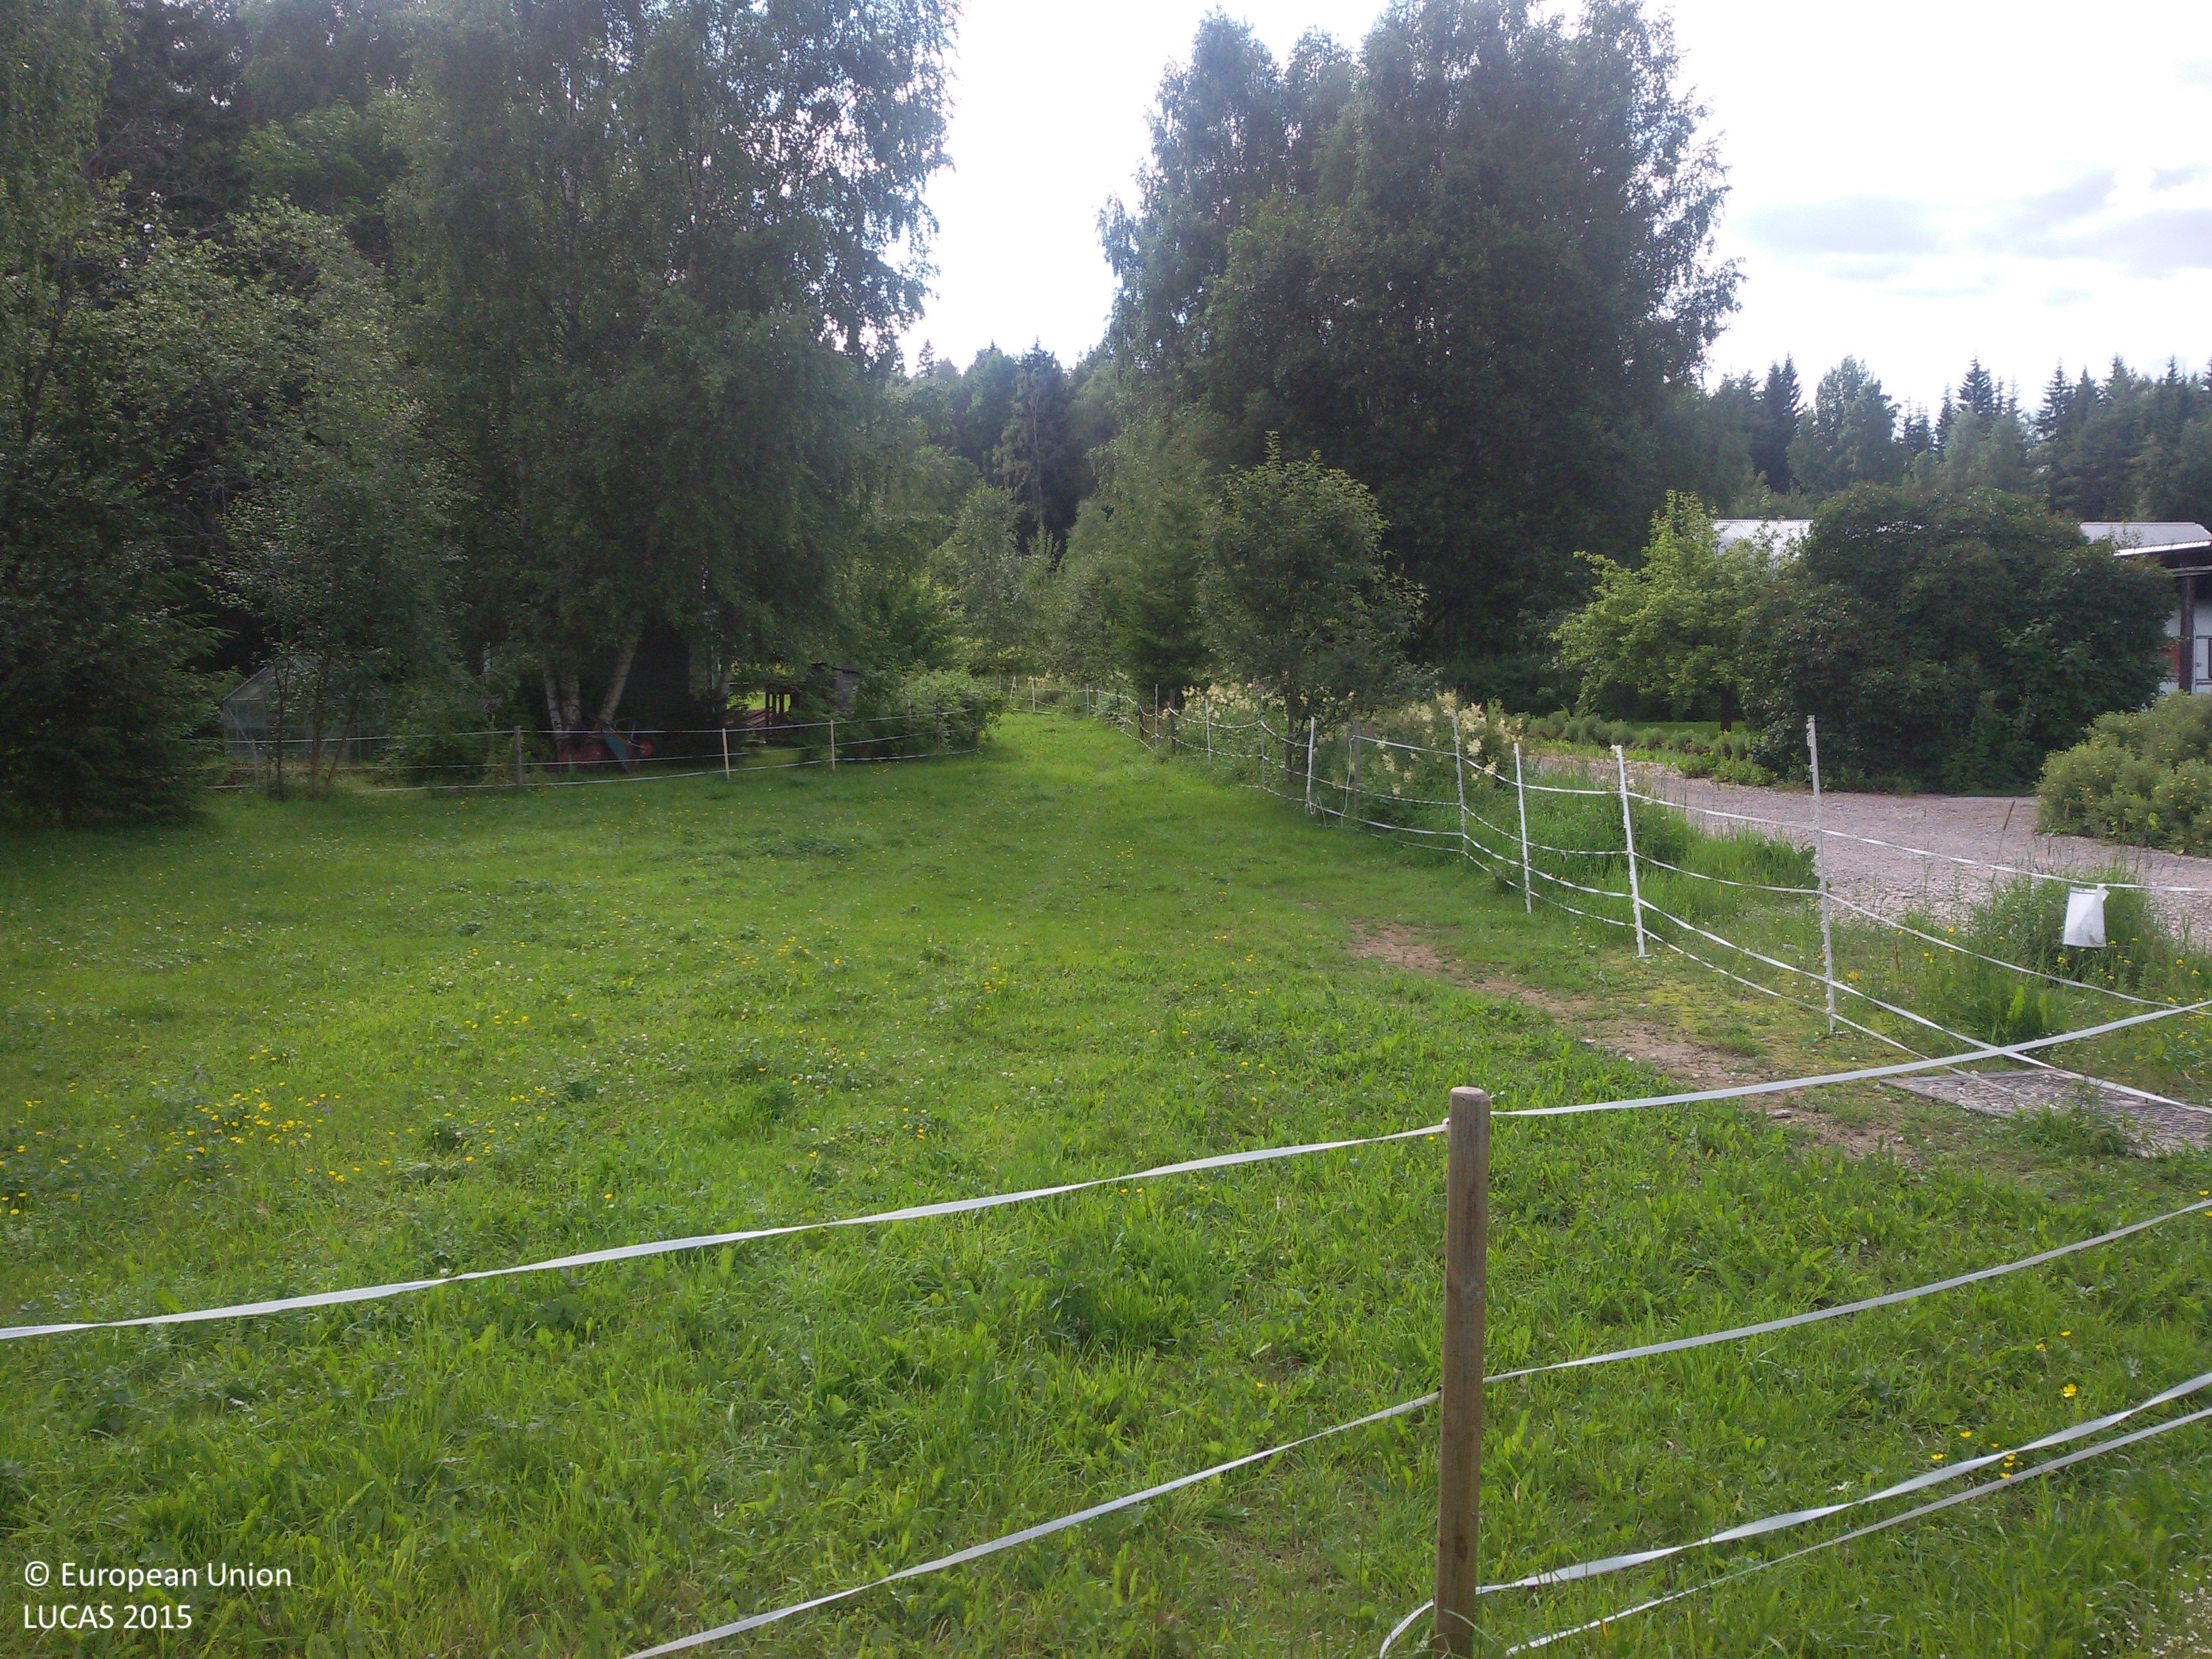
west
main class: Grassland
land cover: Grassland without tree/shrub cover
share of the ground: > 75 %
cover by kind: herbaceous plants 100 %
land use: Road transport
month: July
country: SE
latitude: 60.4748
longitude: 15.3906
